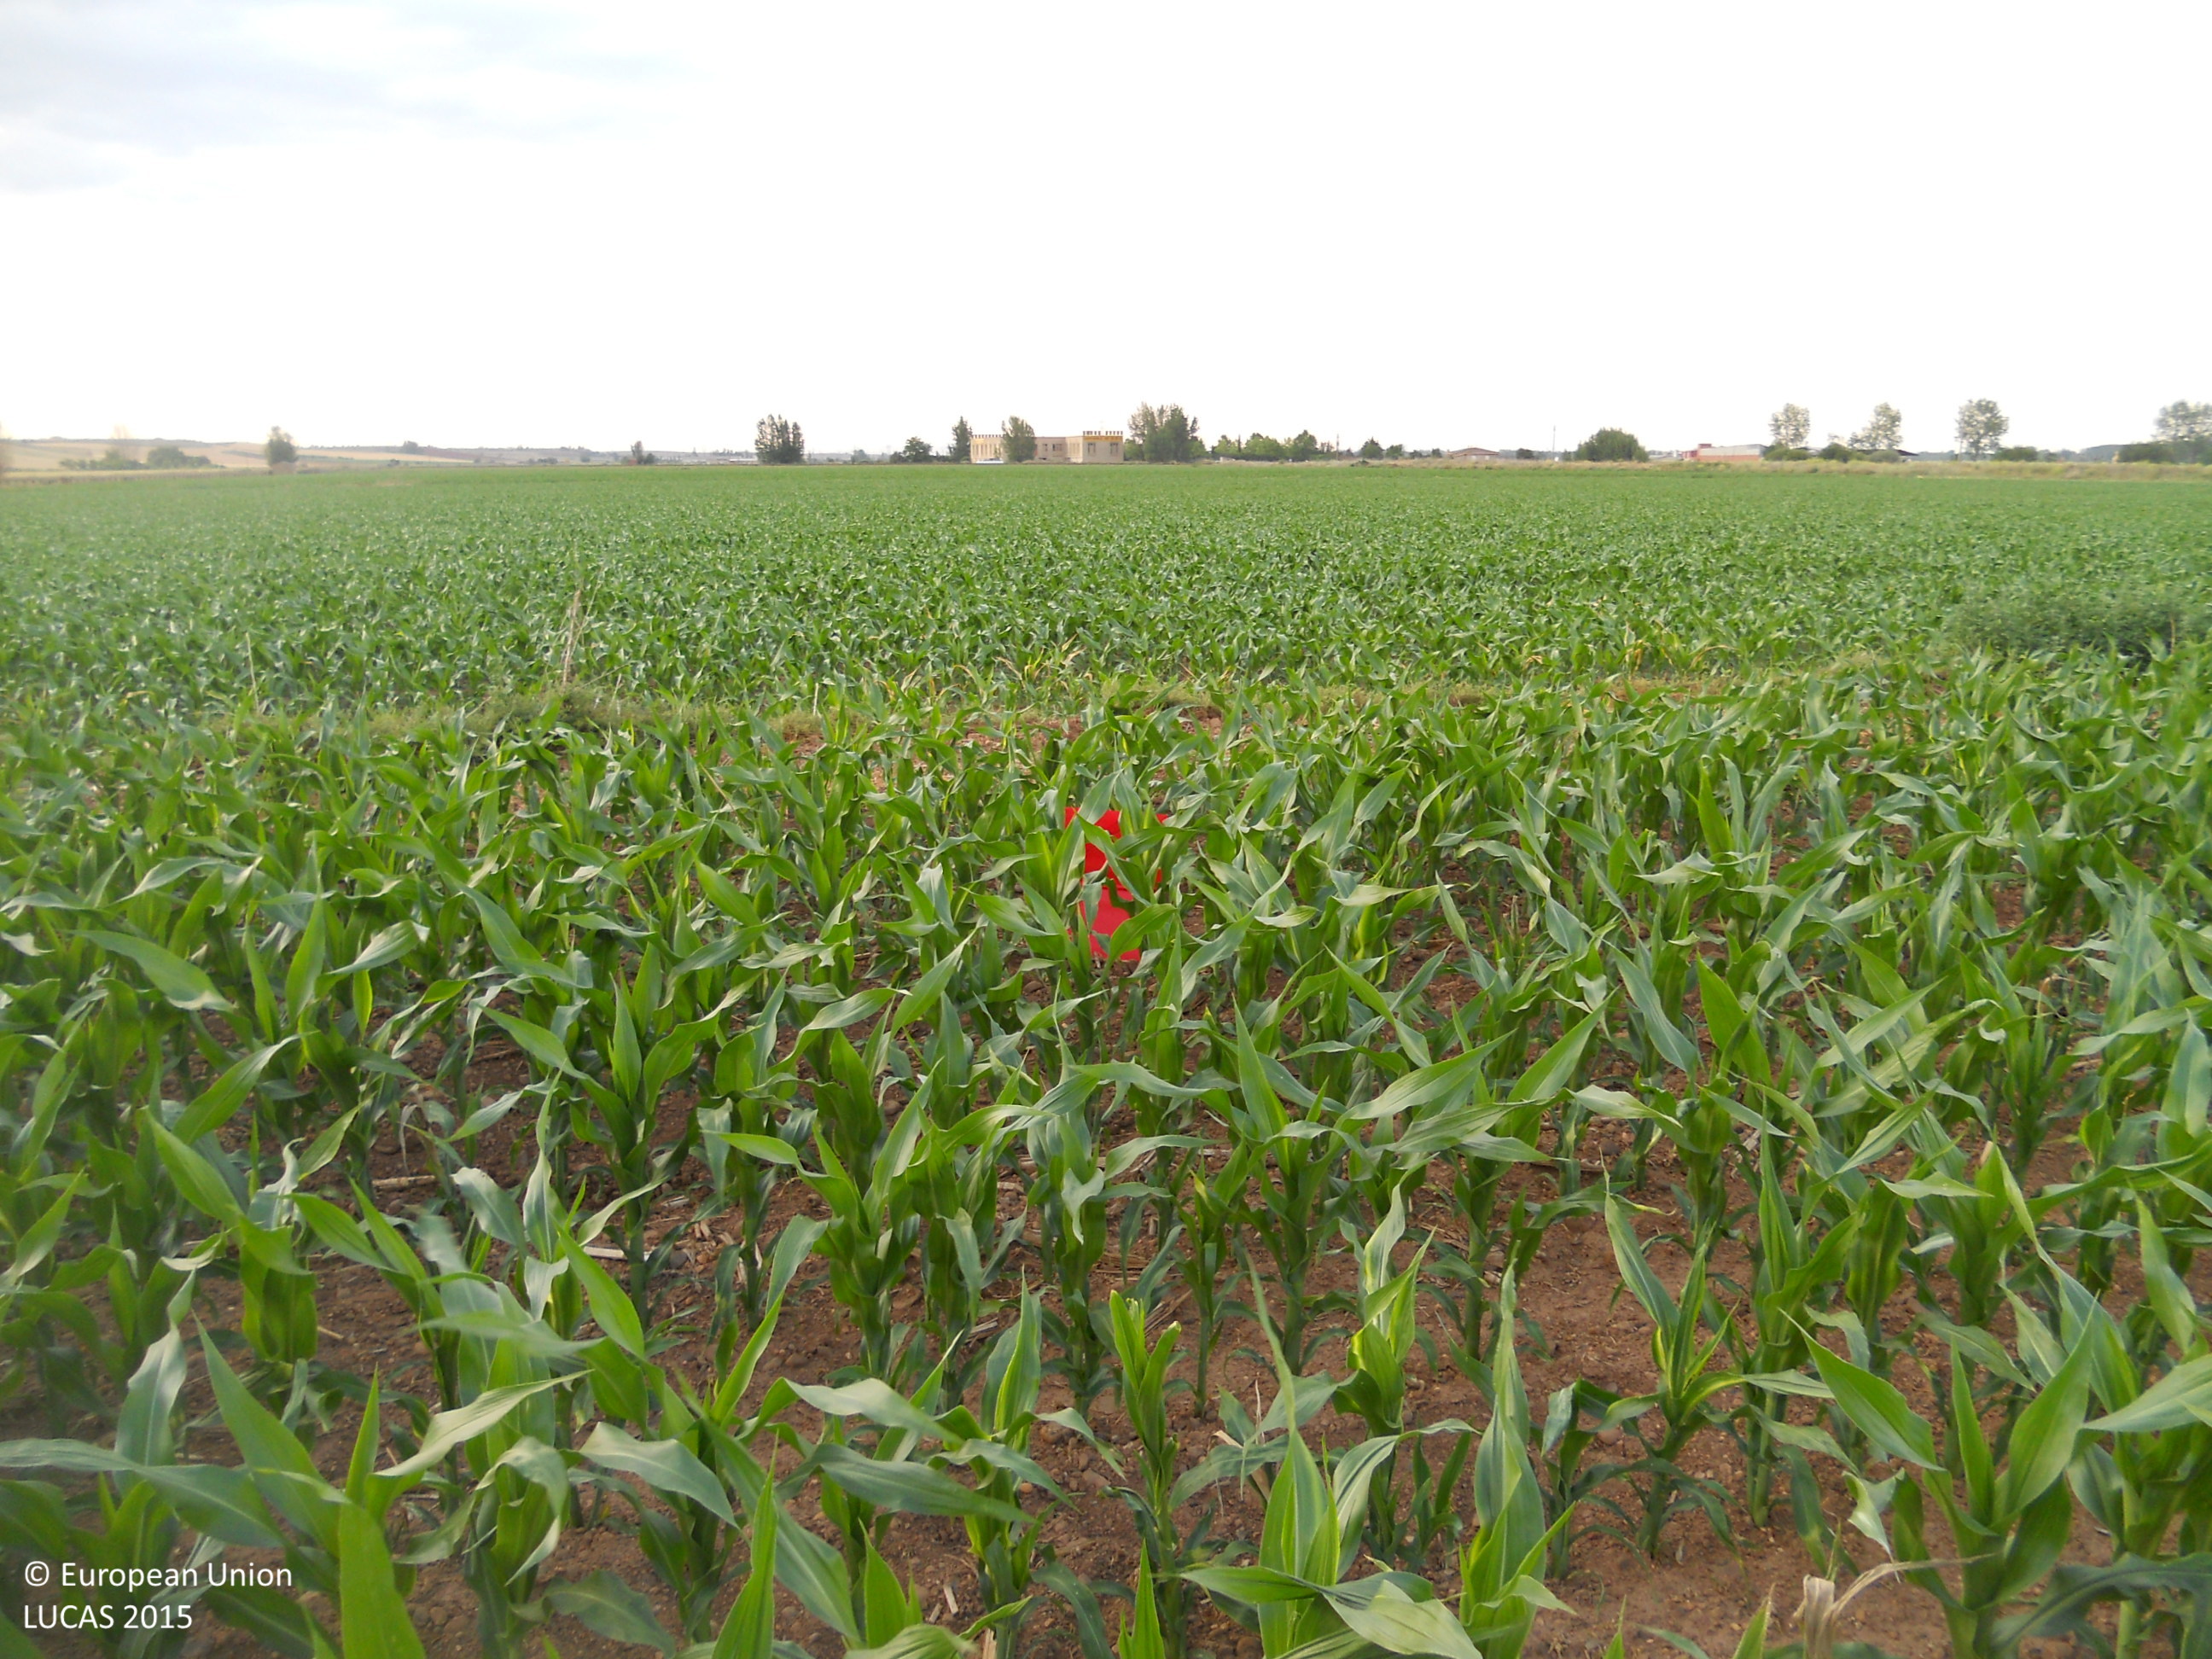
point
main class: Cropland
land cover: Maize
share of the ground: > 75 %
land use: Agriculture (excluding fallow land and kitchen gardens)
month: June
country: ES
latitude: 42.2844
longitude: -5.5795
